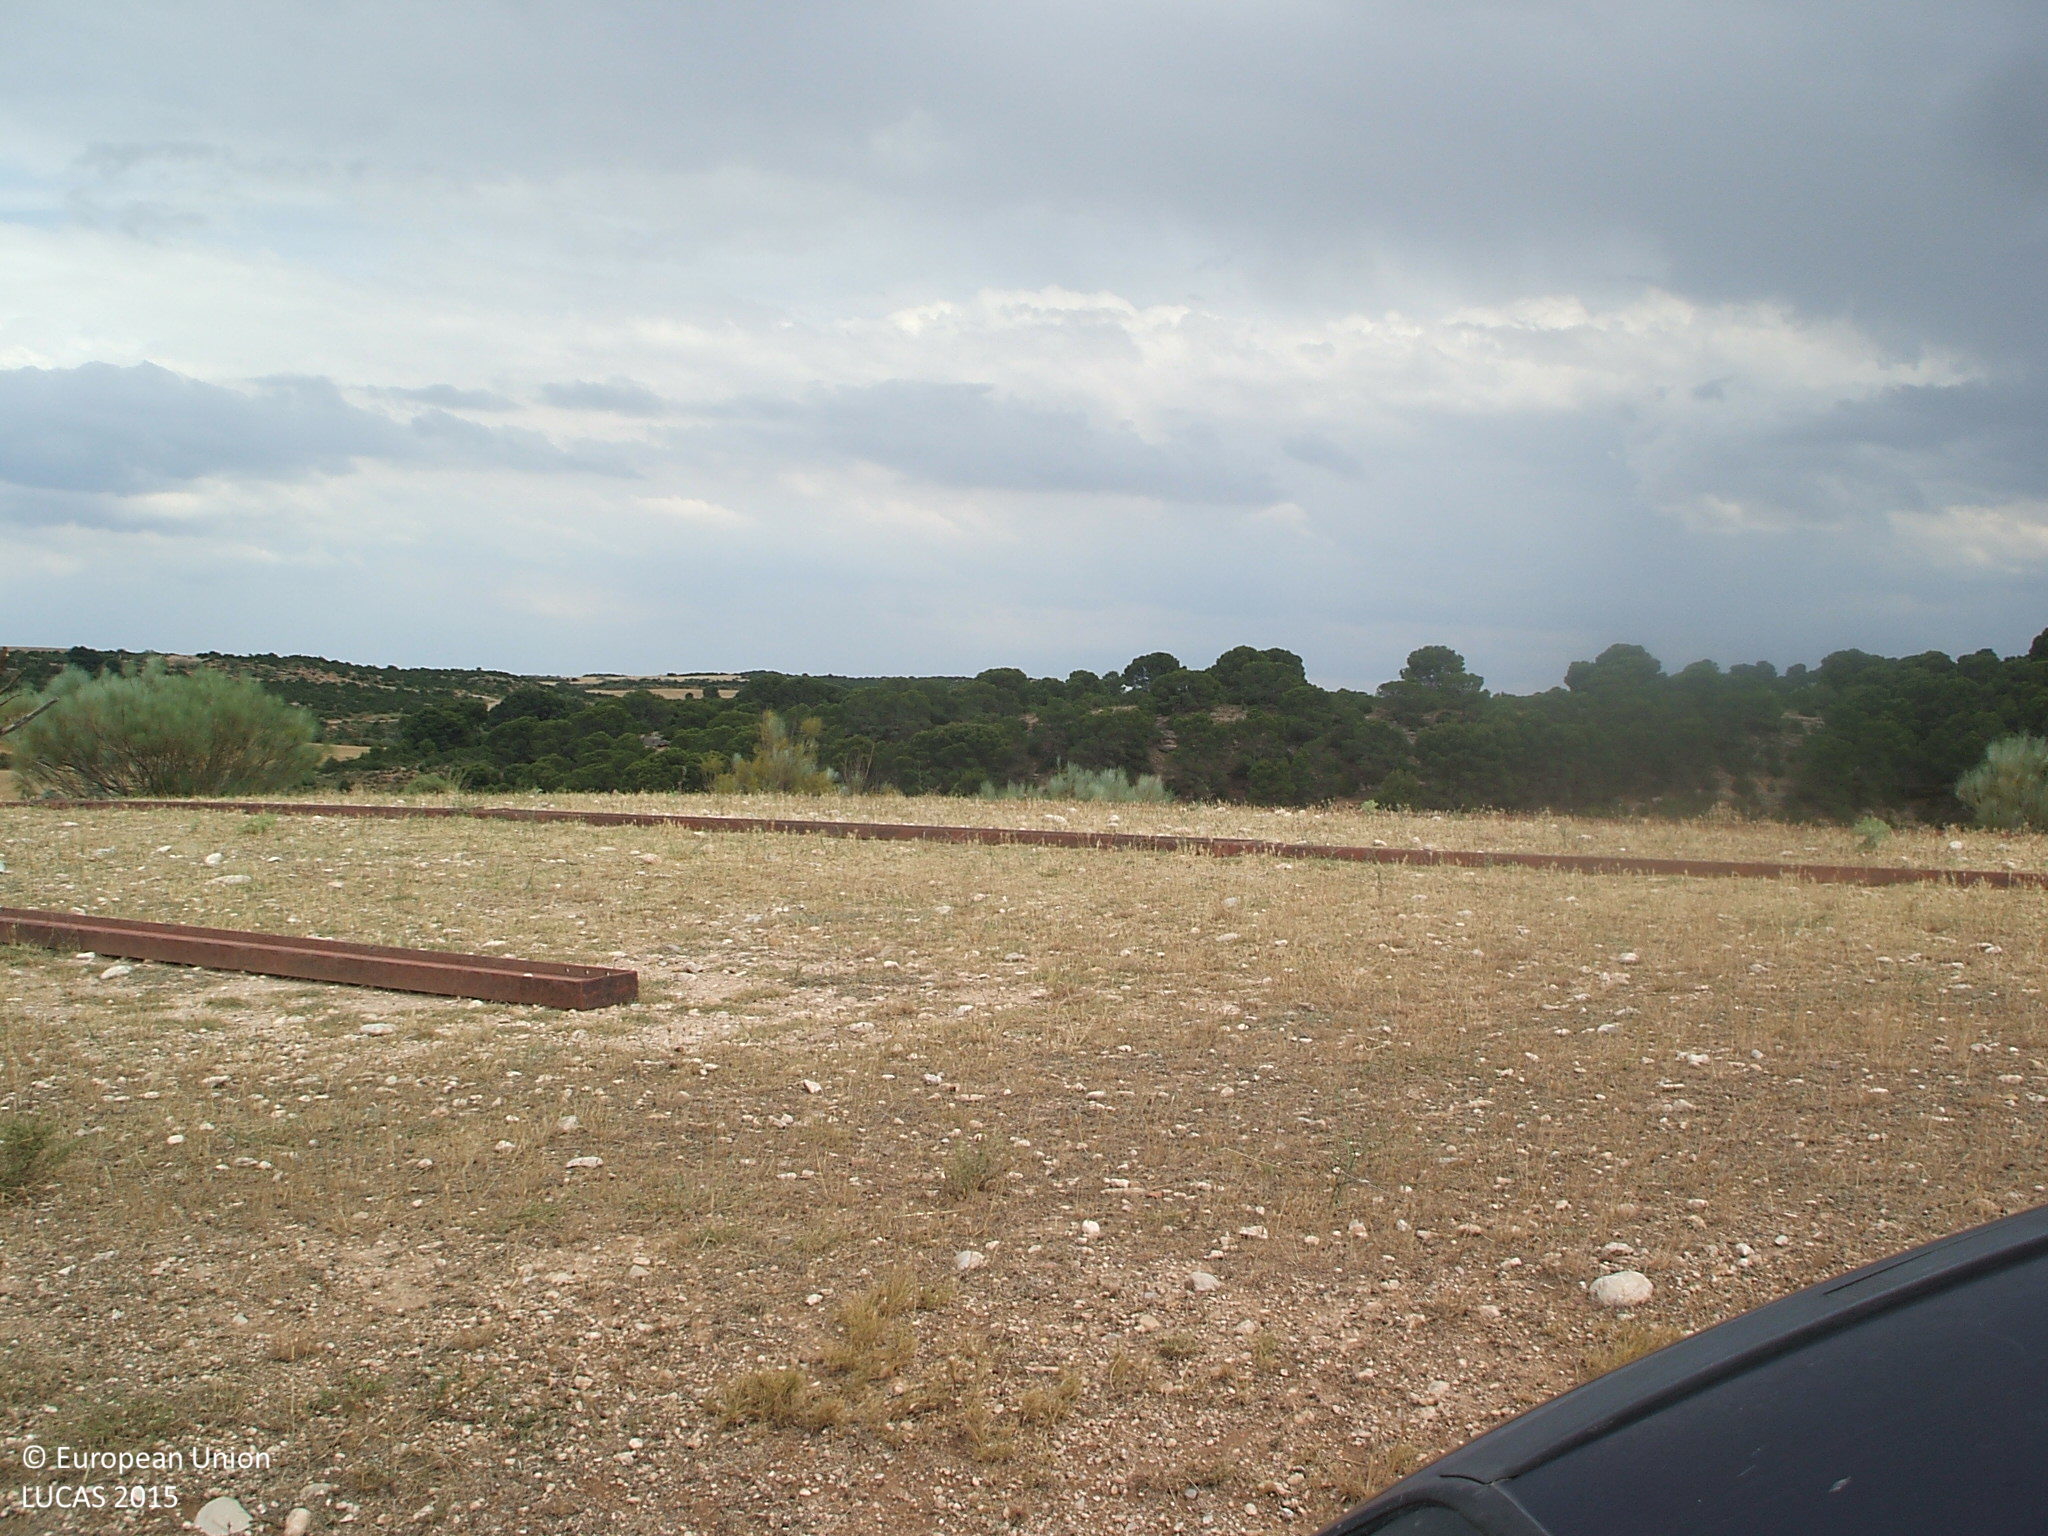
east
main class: Shrubland
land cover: Shrubland with sparse tree cover
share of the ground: > 75 %
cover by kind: shrubs 95 %, coniferous forest trees 5 %
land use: Semi-natural and natural areas not in use
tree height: > 5 m
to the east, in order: Shrubland with sparse tree cover; Shrubland without tree cover; Olive groves; Shrubland with sparse tree cover; Olive groves; Grass margins; Nuts trees; Olive groves; Grass margins; Tracks; Shrubland without tree cover; Arable land (only in case pi); Shrubland without tree cover; Arable land (only in case pi)
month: June
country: ES
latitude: 41.0305
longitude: -0.3483
